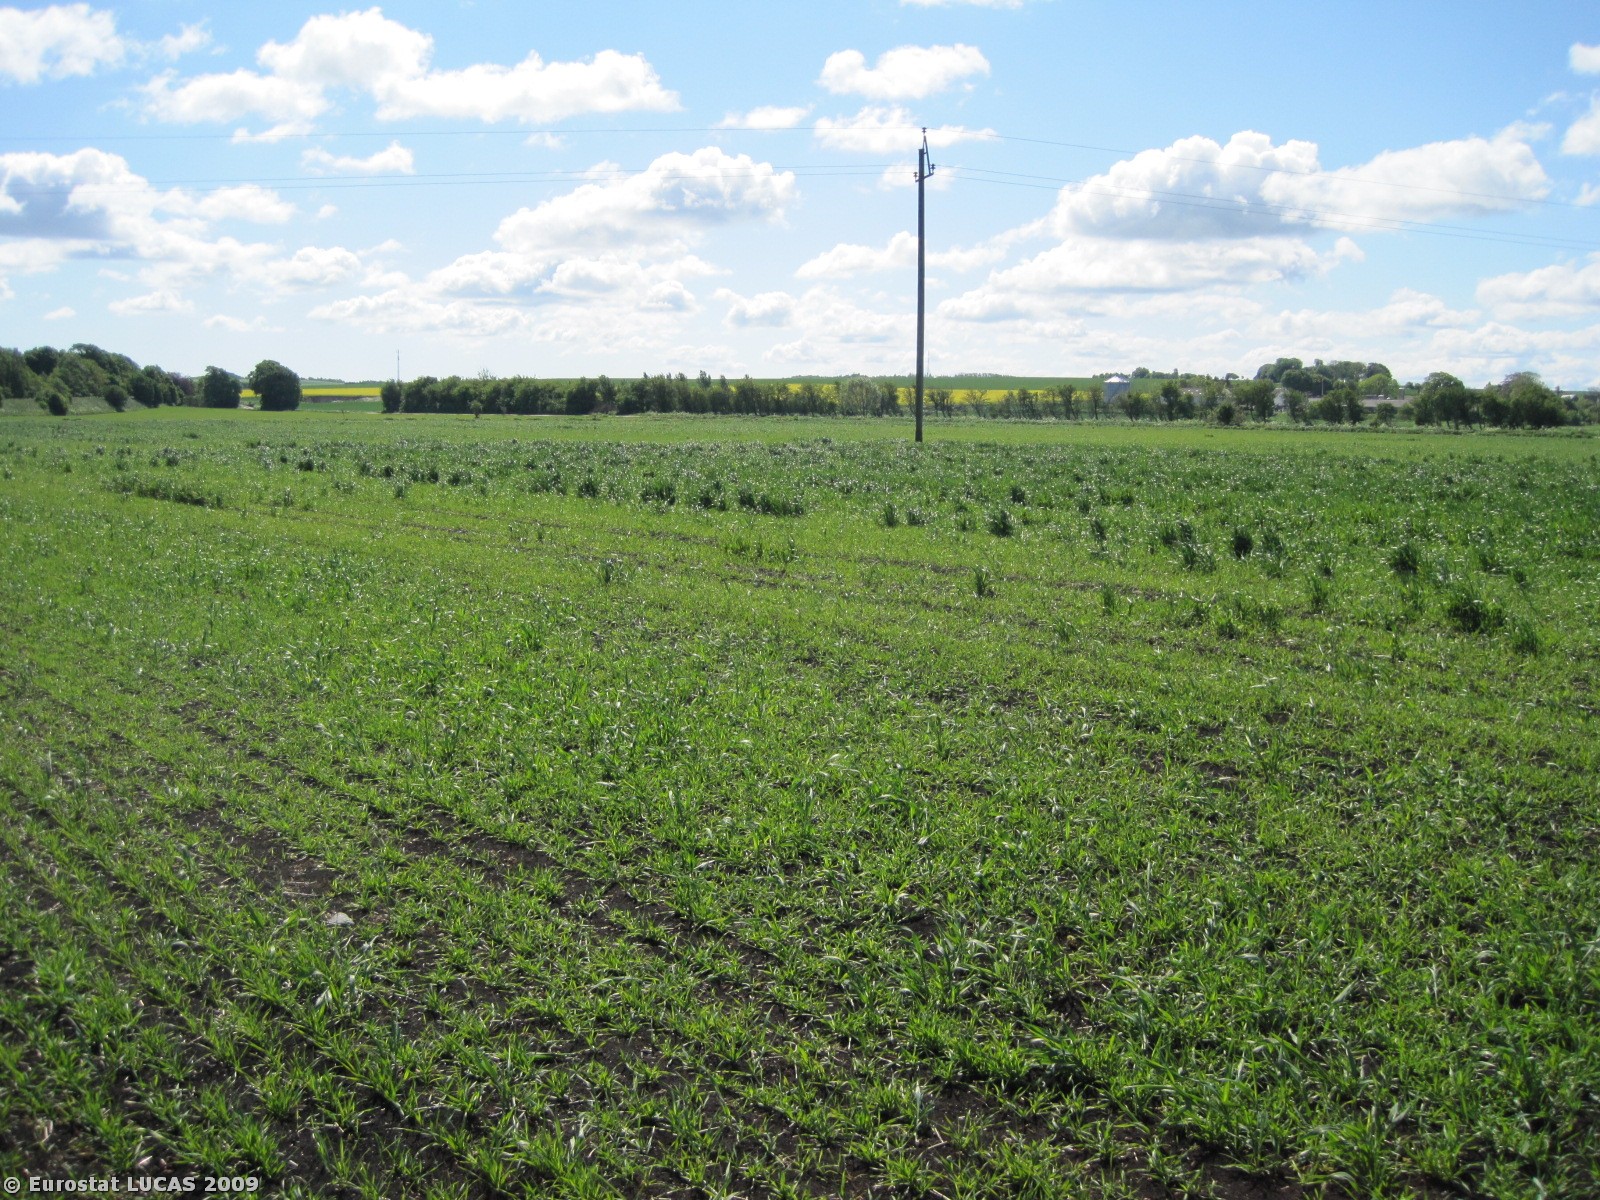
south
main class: Cropland
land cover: Barley
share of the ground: 50 - 75 %
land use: Agriculture (excluding fallow land and kitchen gardens)
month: May
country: DK
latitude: 56.9068
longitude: 10.0820
